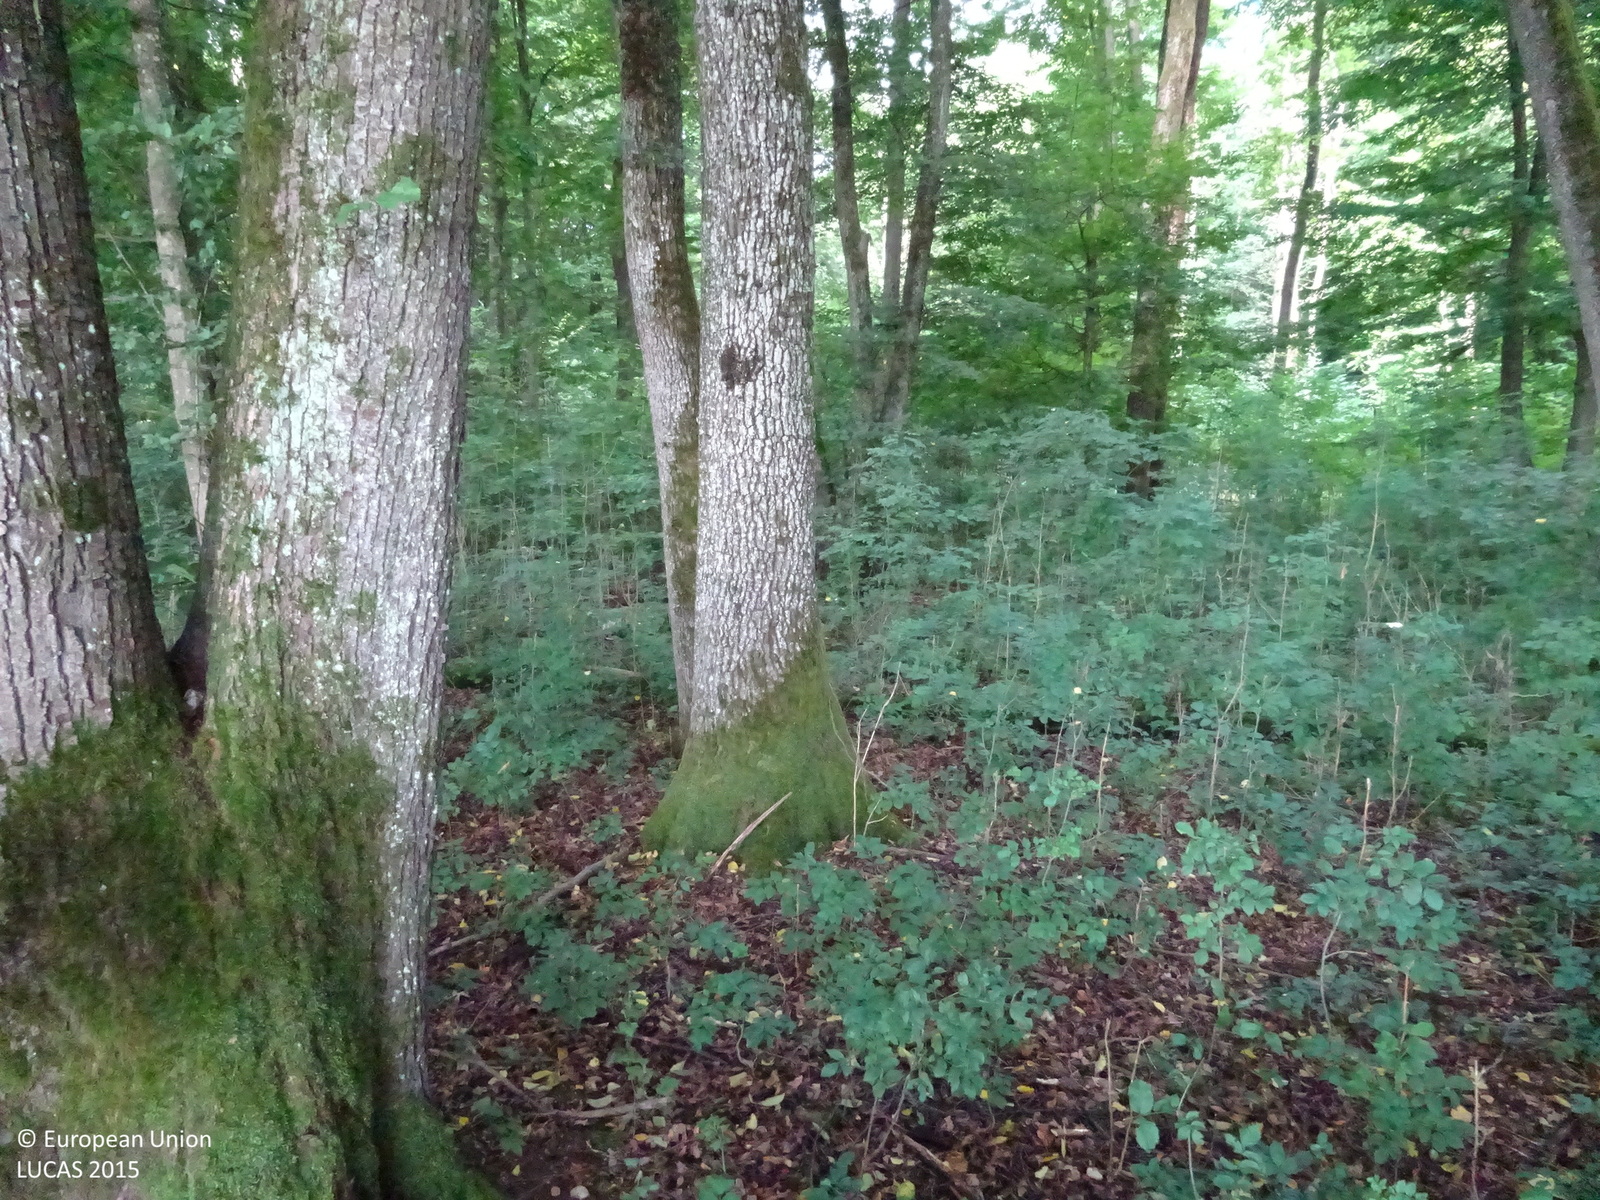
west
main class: Woodland
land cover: Broadleaved woodland
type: hemiboreal forest and nemoral coniferous forest and mixed broadleaved-coniferous forest
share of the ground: > 75 %
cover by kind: broadleaved forest trees 100 %
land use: Forestry
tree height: > 5 m
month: July
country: AT
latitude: 46.9149
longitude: 15.4749
